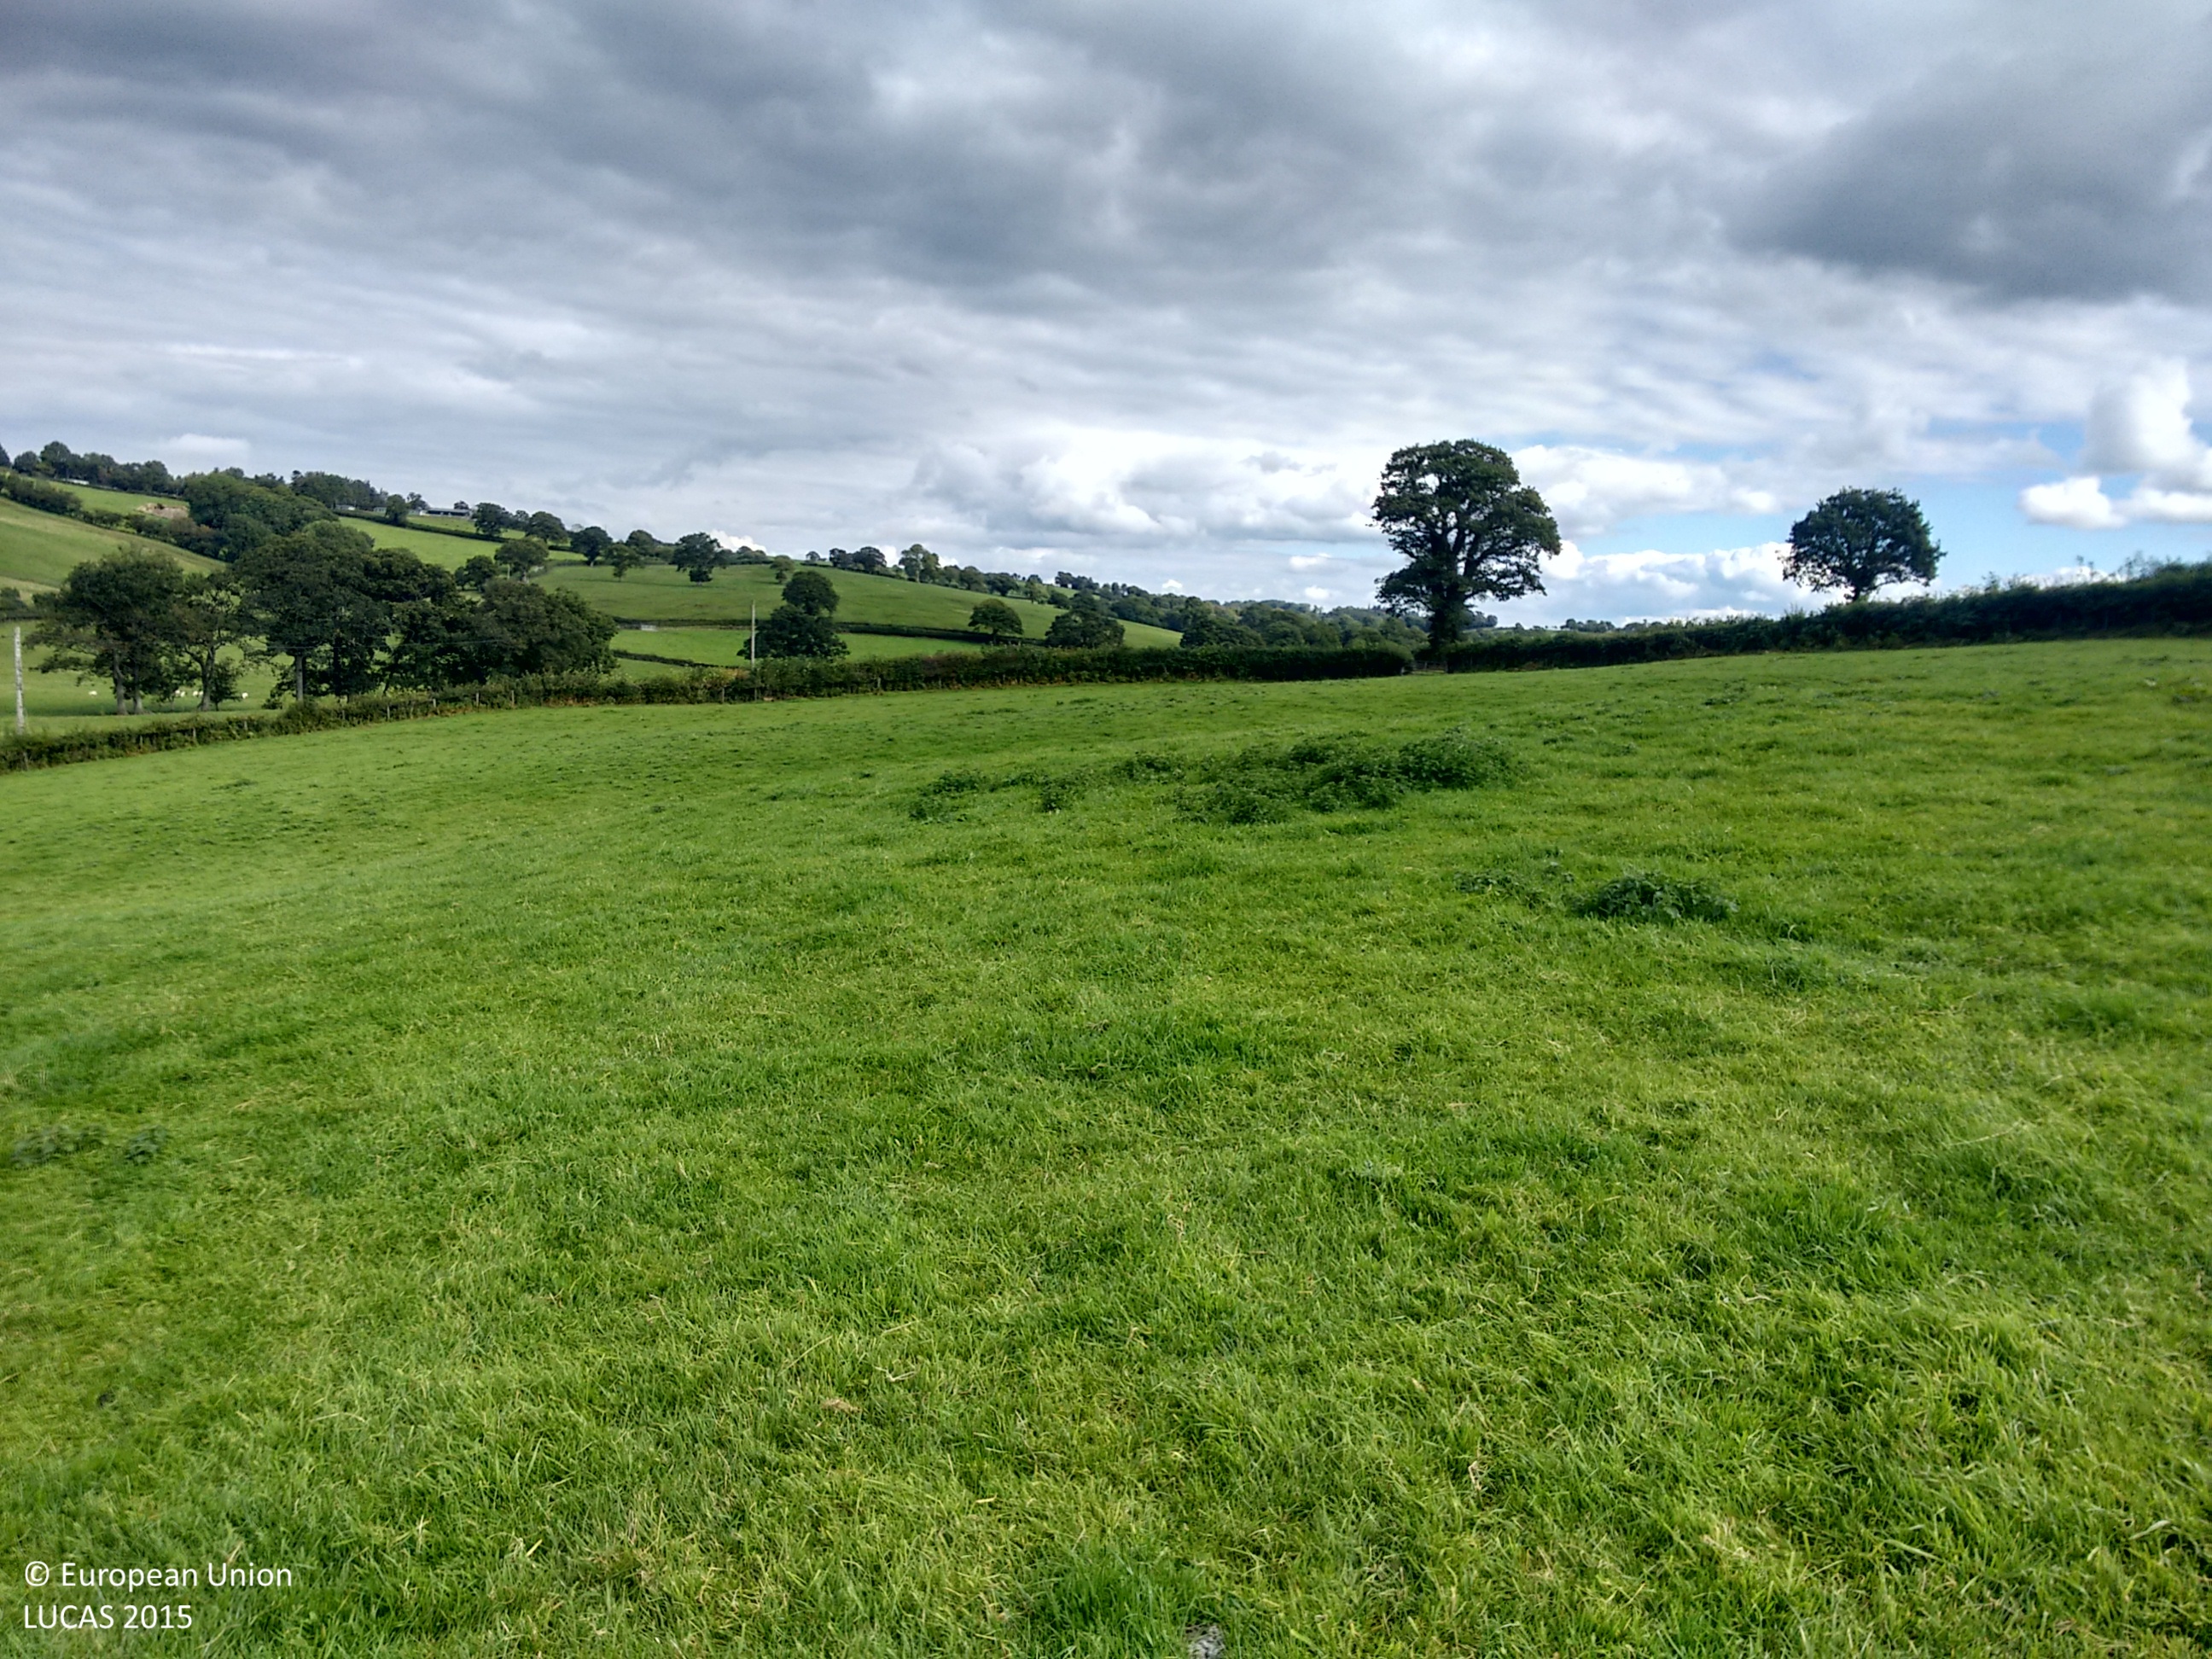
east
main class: Grassland
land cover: Grassland without tree/shrub cover
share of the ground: > 75 %
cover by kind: herbaceous plants 100 %
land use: Agriculture (excluding fallow land and kitchen gardens)
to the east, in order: Grassland without tree/shrub cover; Managed hedges; Grass margins; Paved roads, cycling and walking lanes; Grass margins; Managed hedges; Grassland without tree/shrub cover
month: September
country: GB
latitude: 52.6944
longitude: -3.3537
